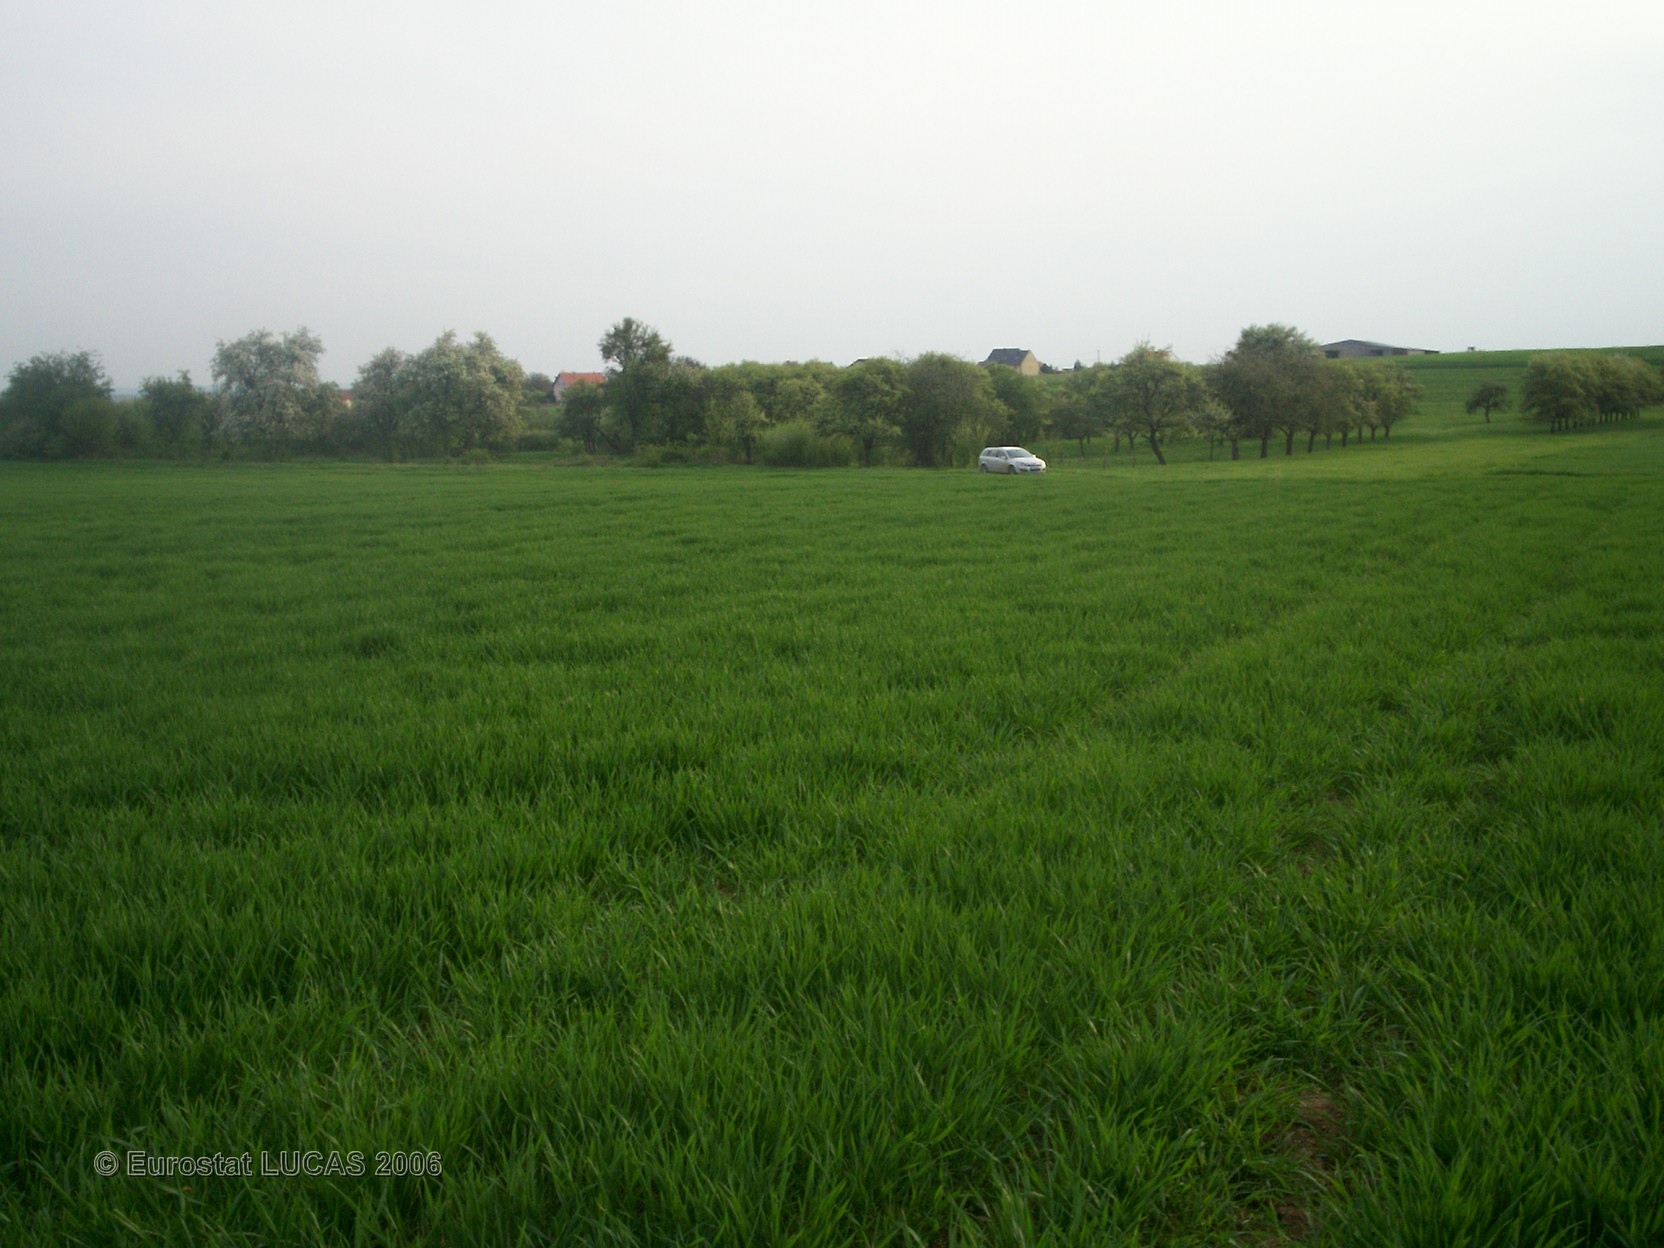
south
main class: Cropland
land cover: Common wheat
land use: Agriculture (excluding fallow land and kitchen gardens)
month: May
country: FR
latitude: 49.1362
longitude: 6.9712
